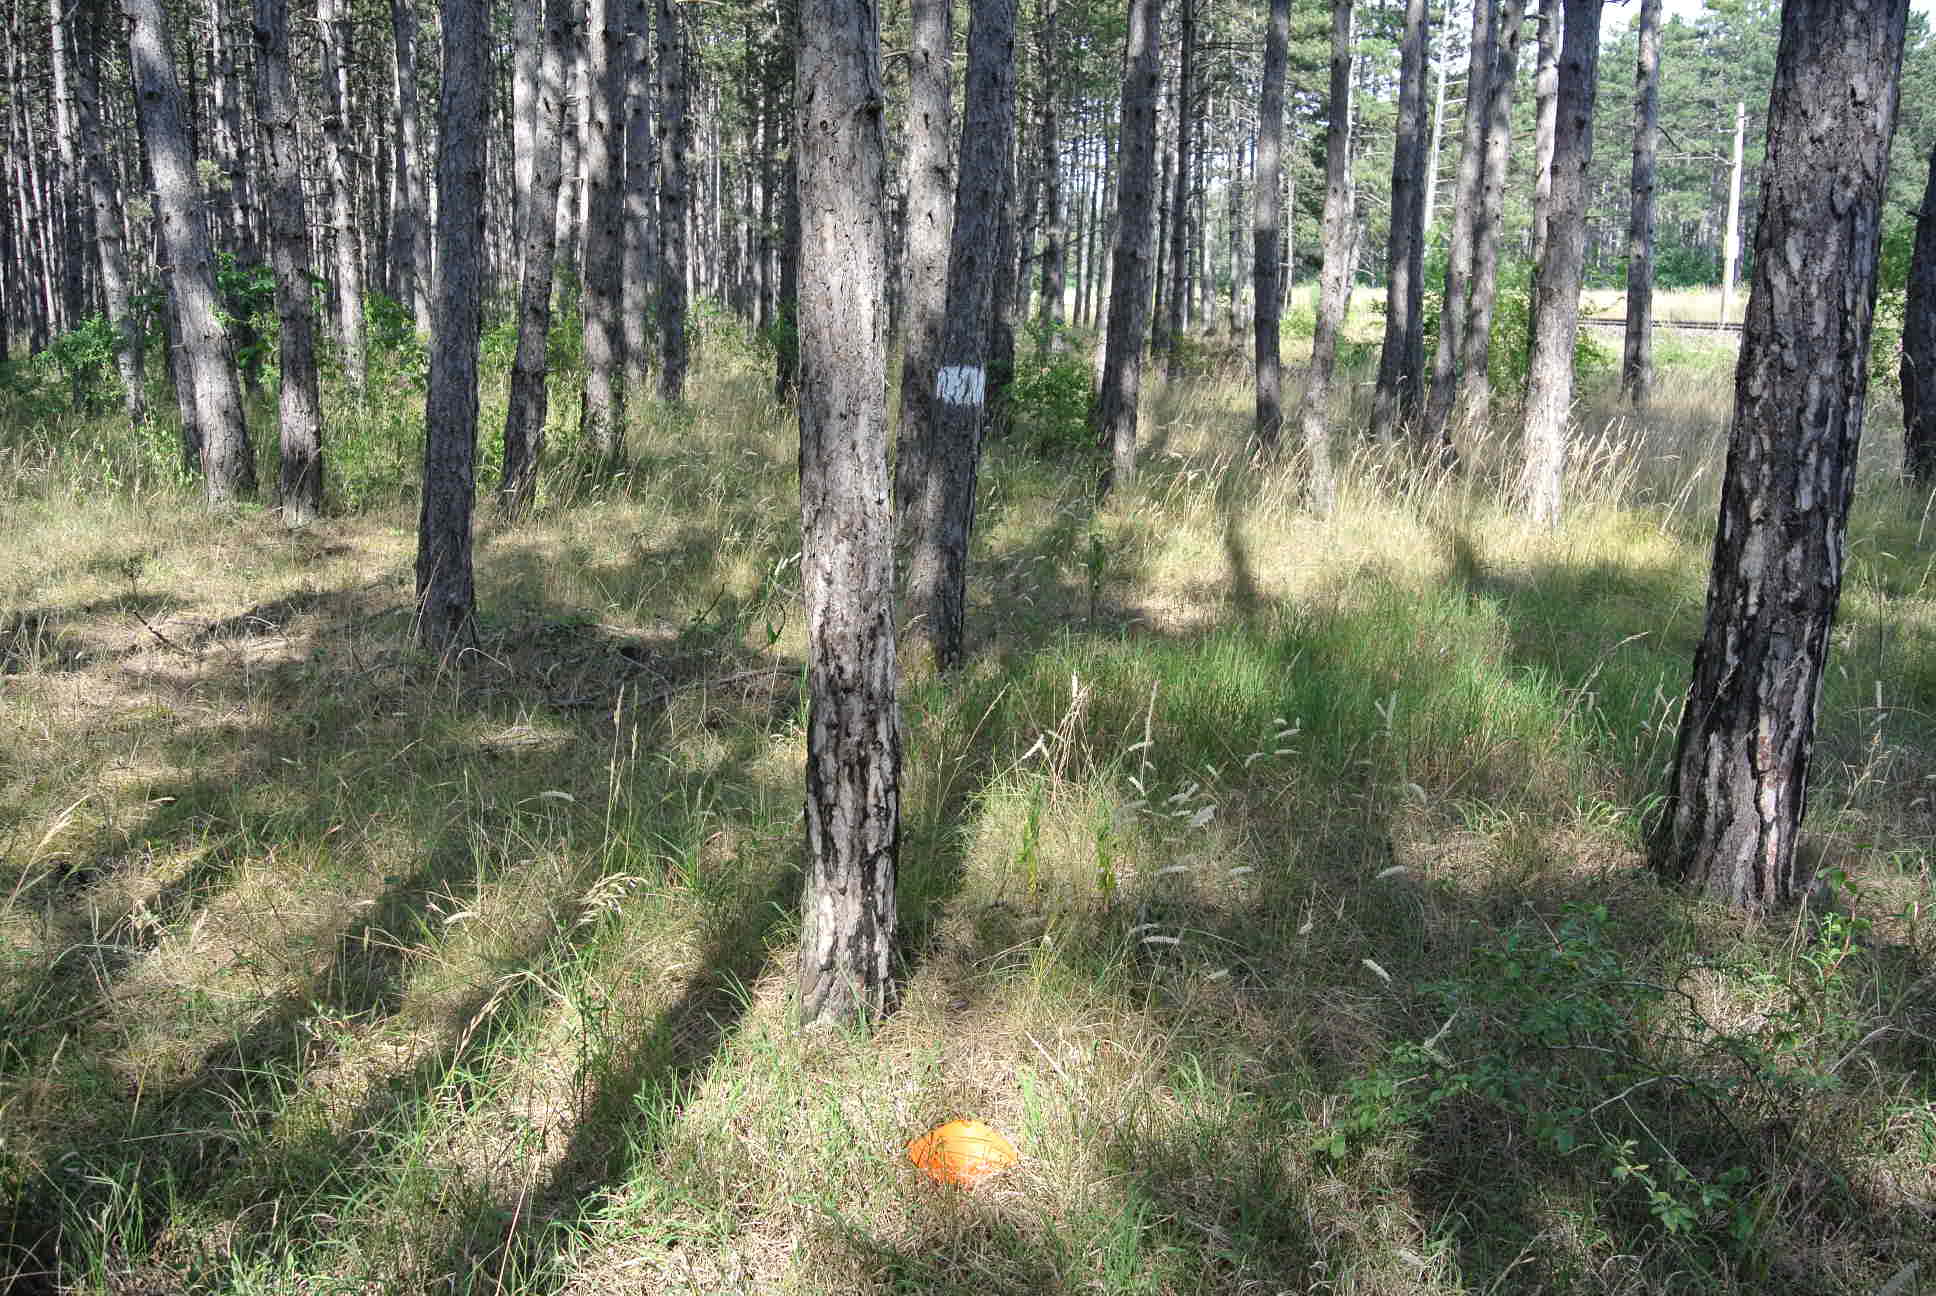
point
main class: Woodland
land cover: Pine dominated coniferous woodland
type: alpine coniferous forest
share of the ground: > 75 %
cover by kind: coniferous forest trees 90 %, herbaceous plants 10 %
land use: Forestry
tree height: > 5 m
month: July
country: AT
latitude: 47.7793
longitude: 16.1826
